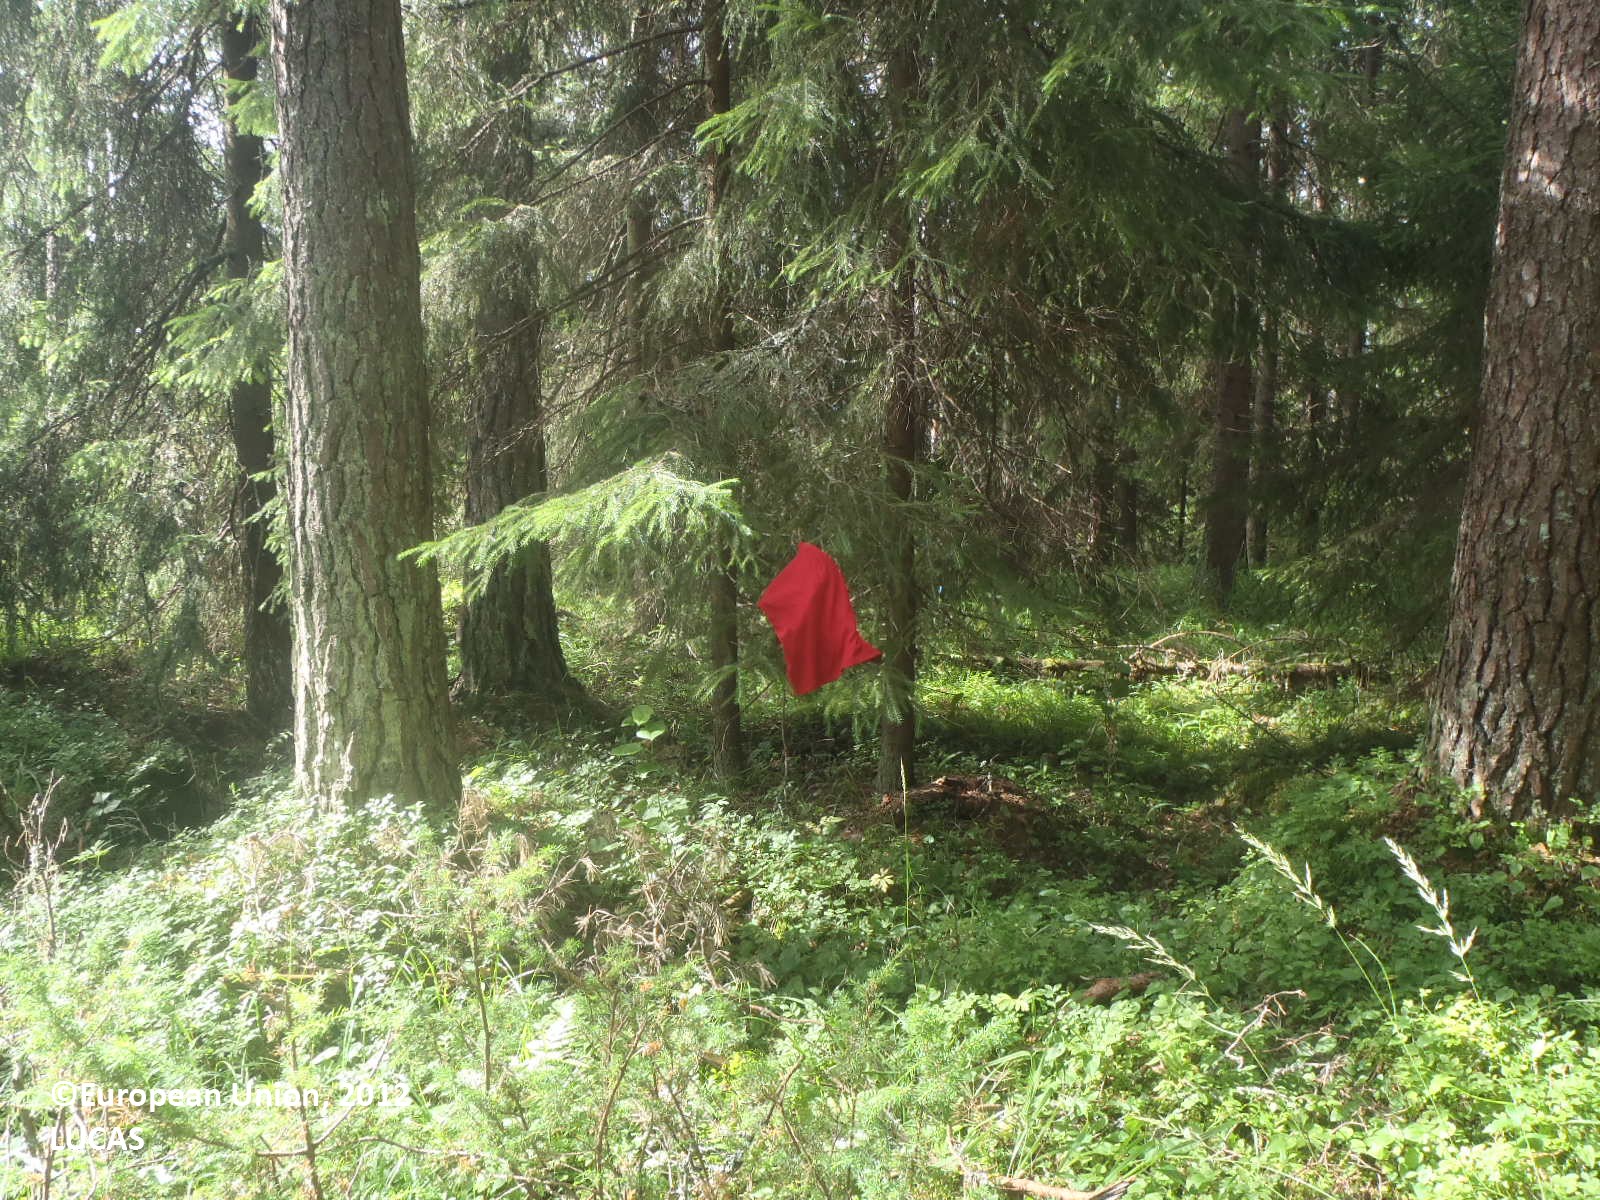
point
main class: Woodland
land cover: Other coniferous woodland
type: boreal forest
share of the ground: 50 - 75 %
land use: Forestry
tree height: > 5 m
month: July
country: FI
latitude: 61.0969
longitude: 21.9099
